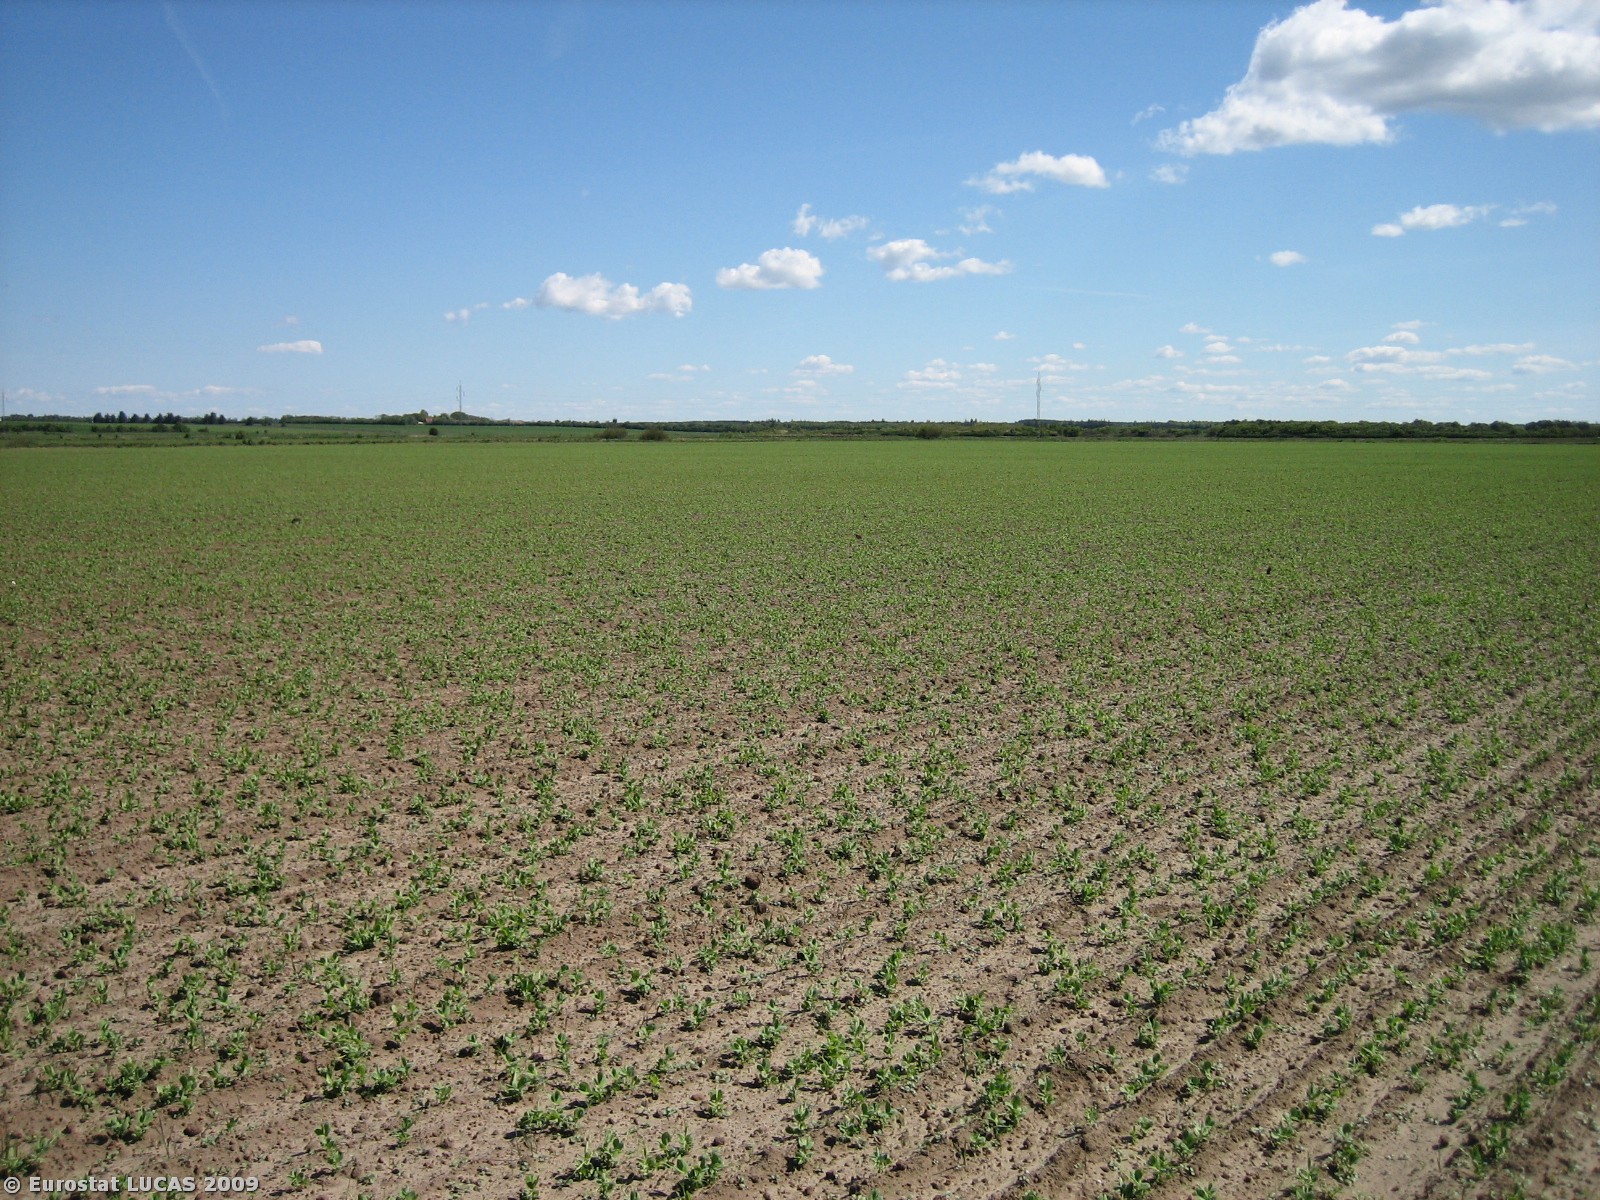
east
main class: Cropland
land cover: Dry pulses
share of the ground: 25 - 50 %
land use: Agriculture (excluding fallow land and kitchen gardens)
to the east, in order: Dry pulses
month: May
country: DK
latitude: 56.2849
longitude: 8.3380
